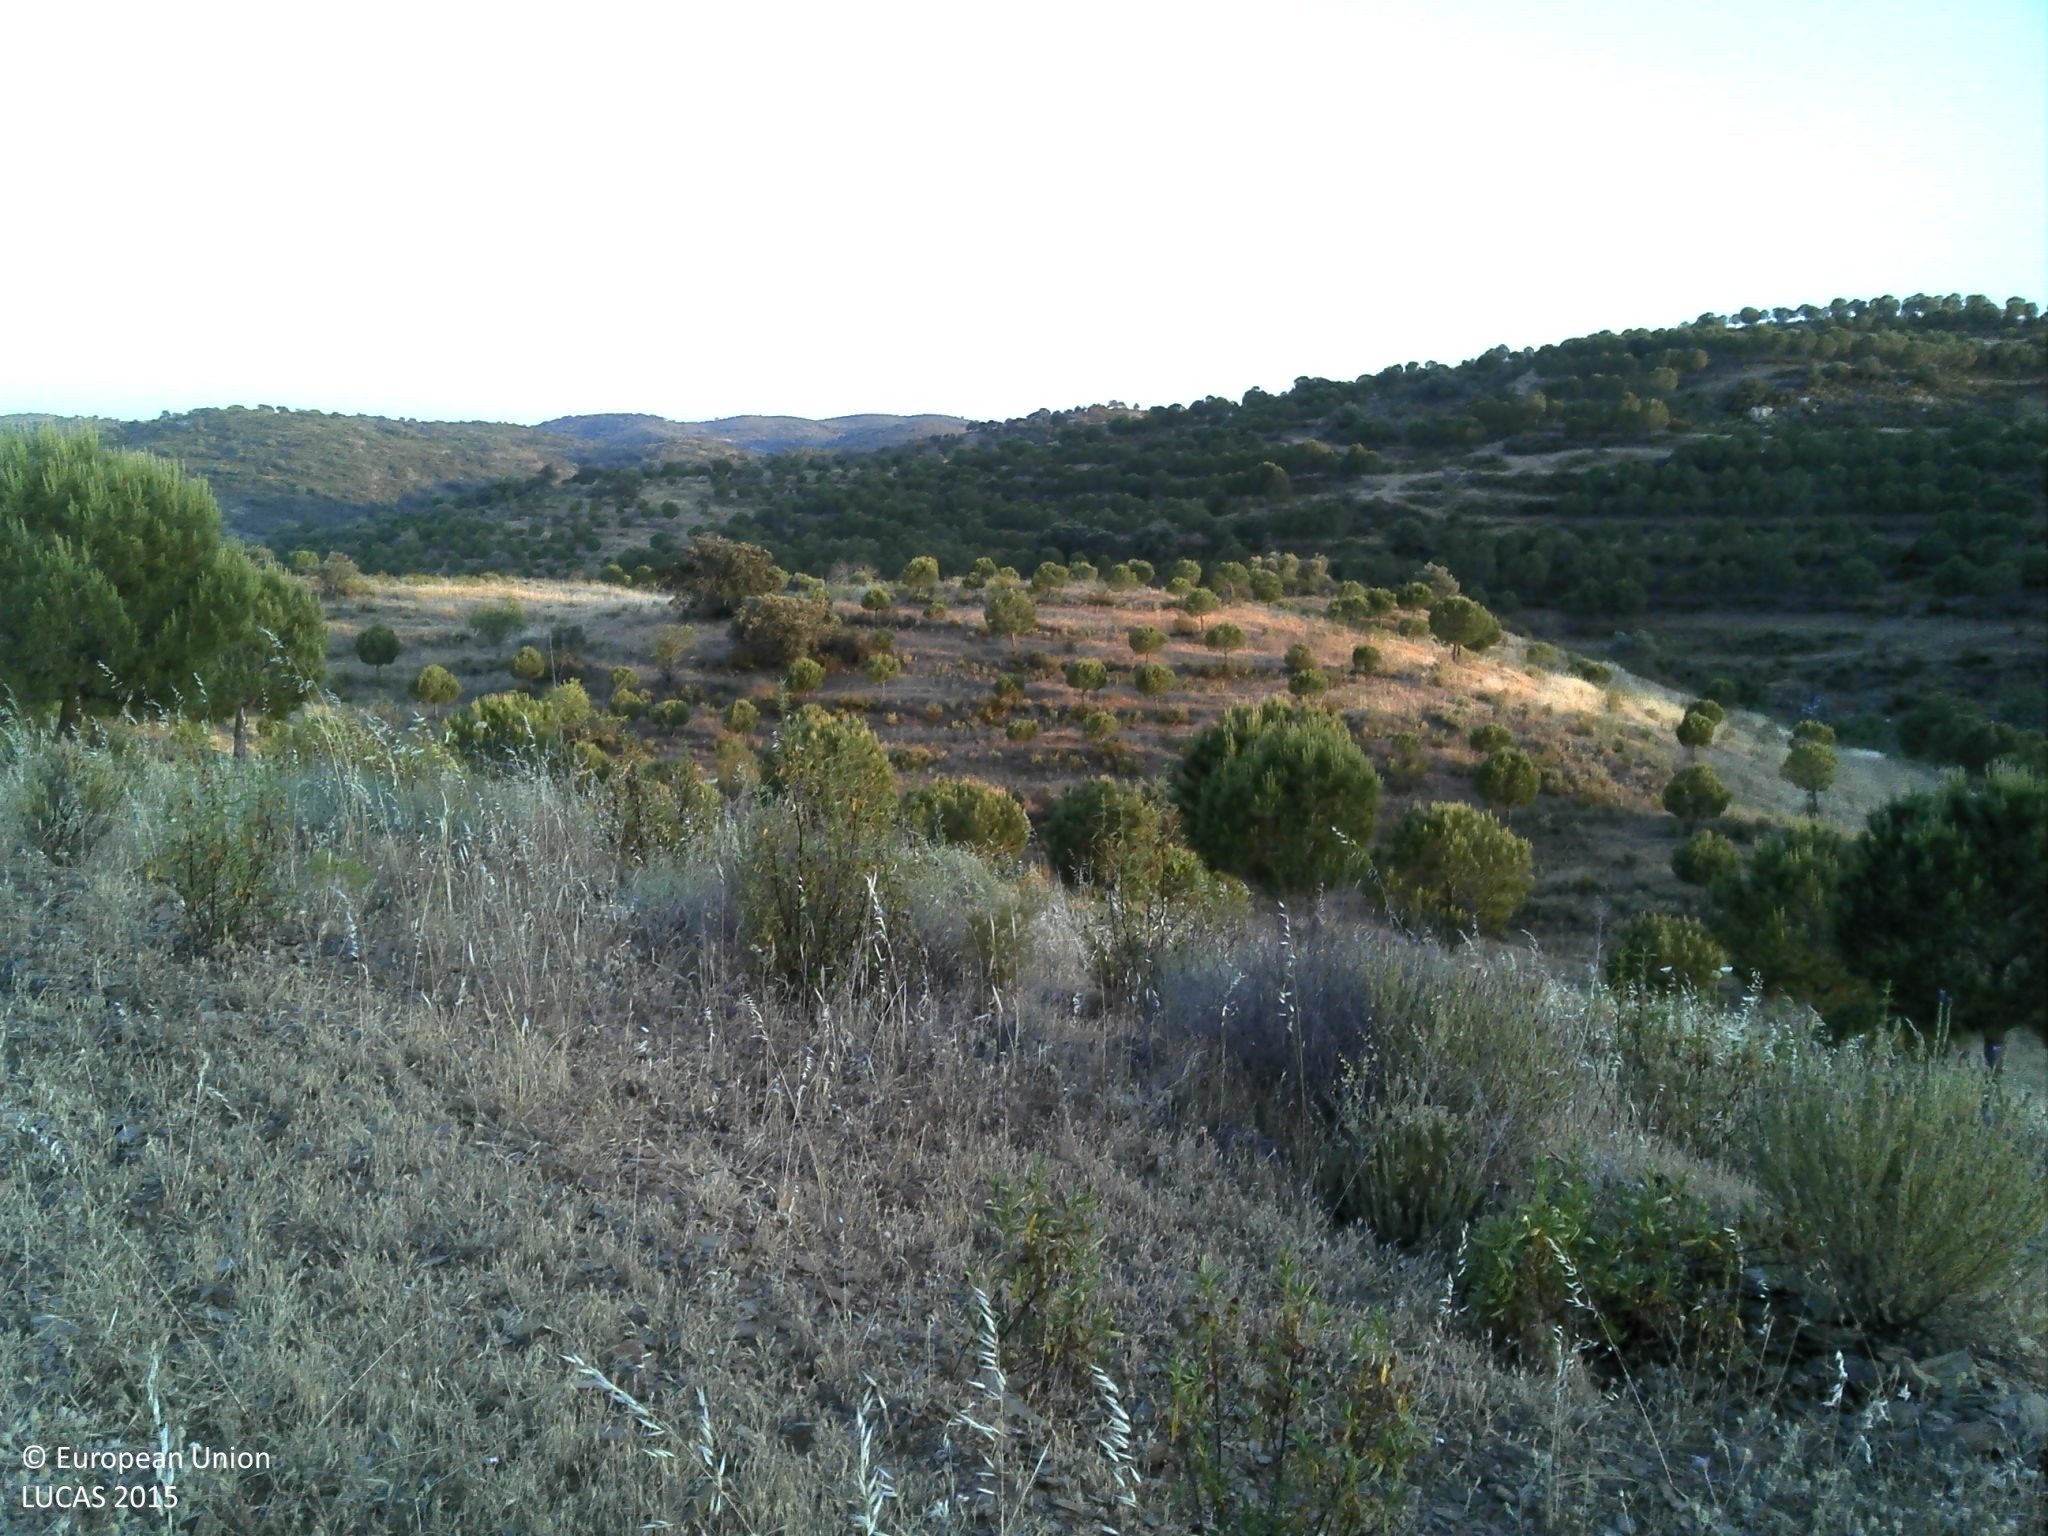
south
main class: Woodland
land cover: Pine dominated coniferous woodland
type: coniferous forest of the mediterranean region
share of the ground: 10 - 25 %
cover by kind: herbaceous plants 60 %, coniferous forest trees 25 %, consolidated bare surface 10 %, shrubs 5 %
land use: Forestry
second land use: Agriculture (excluding fallow land and kitchen gardens)
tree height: < 5 m
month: May
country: PT
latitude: 37.4863
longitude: -7.7592
